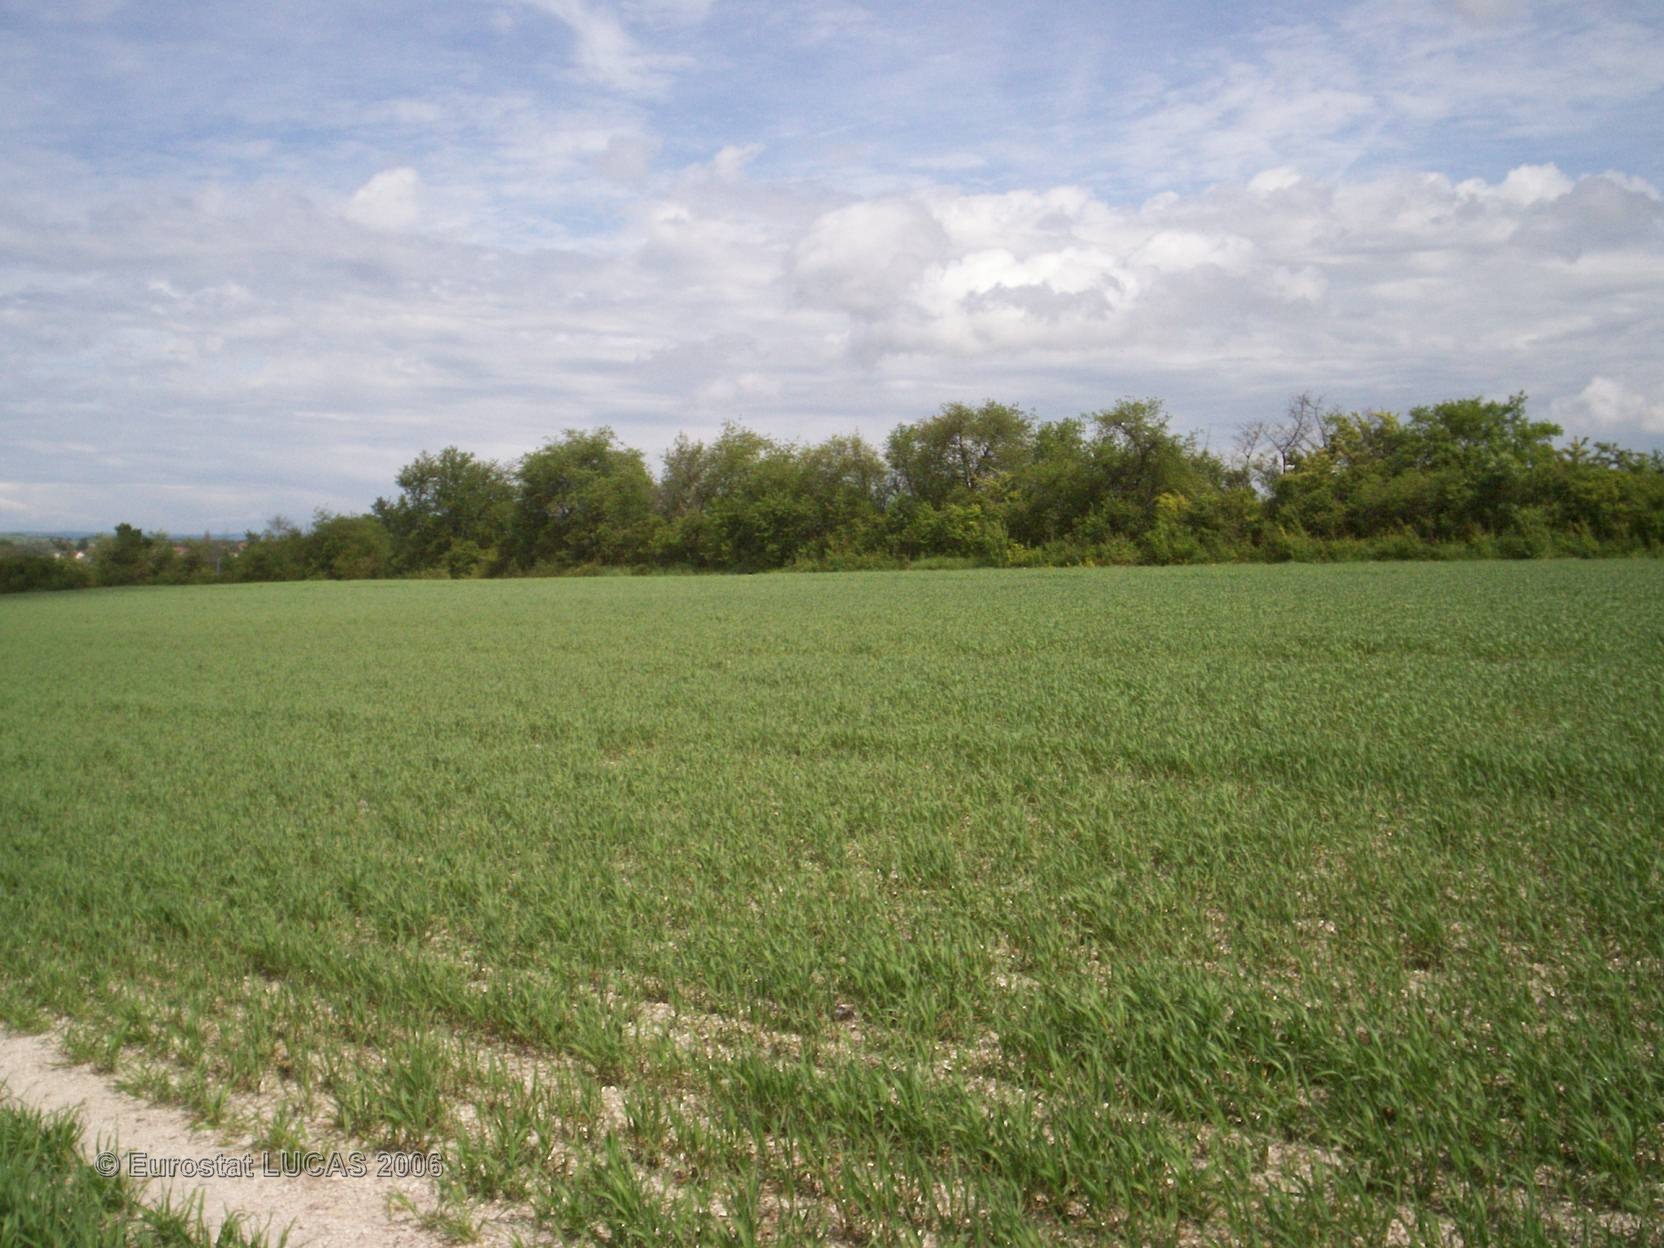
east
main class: Cropland
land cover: Barley
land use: Agriculture (excluding fallow land and kitchen gardens)
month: May
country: FR
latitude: 49.4853
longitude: 4.3501
